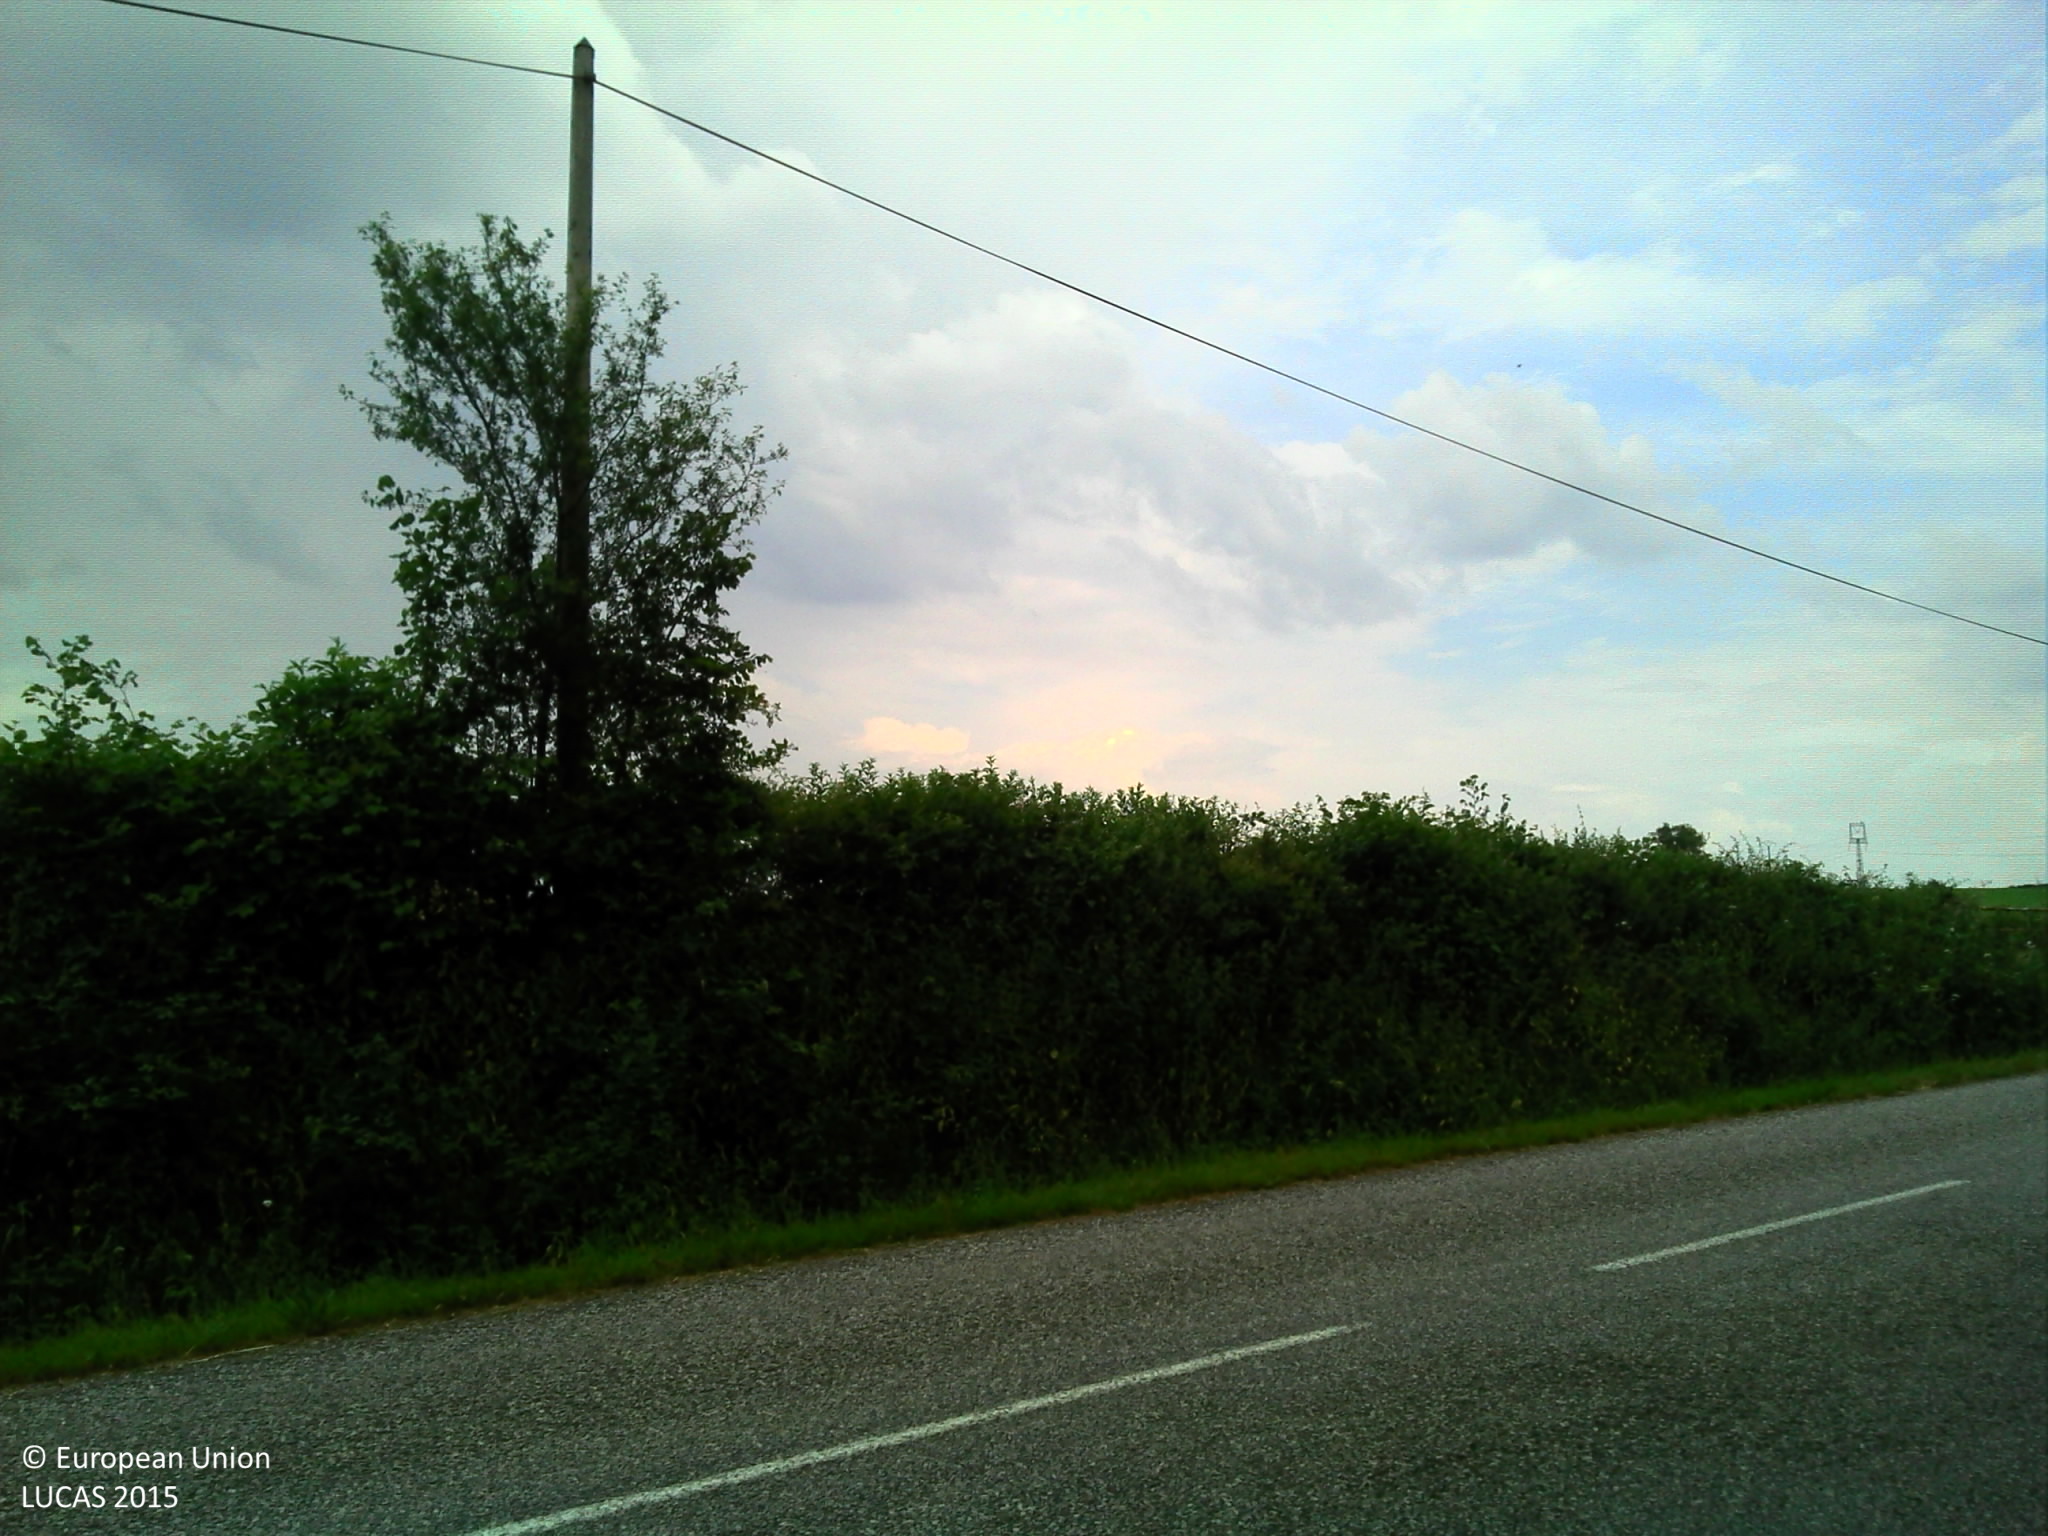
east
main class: Woodland
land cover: Broadleaved woodland
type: mesophytic deciduous forest
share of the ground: > 75 %
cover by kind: broadleaved forest trees 90 %, shrubs 5 %, herbaceous plants 5 %
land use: Forestry
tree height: > 5 m
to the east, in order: Broadleaved woodland; Ditches and canals; Grass margins; Paved roads, cycling and walking lanes; Grass margins; Electric lines; Managed hedges; Fences; Grassland with sparse tree/shrub cover; Fences; Managed hedges; Single bushes/trees; Temporary grasslands; Fences; Ditches and canals; Managed hedges; Grassland without tree/shrub cover
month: June
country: FR
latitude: 46.3042
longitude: 3.0256
